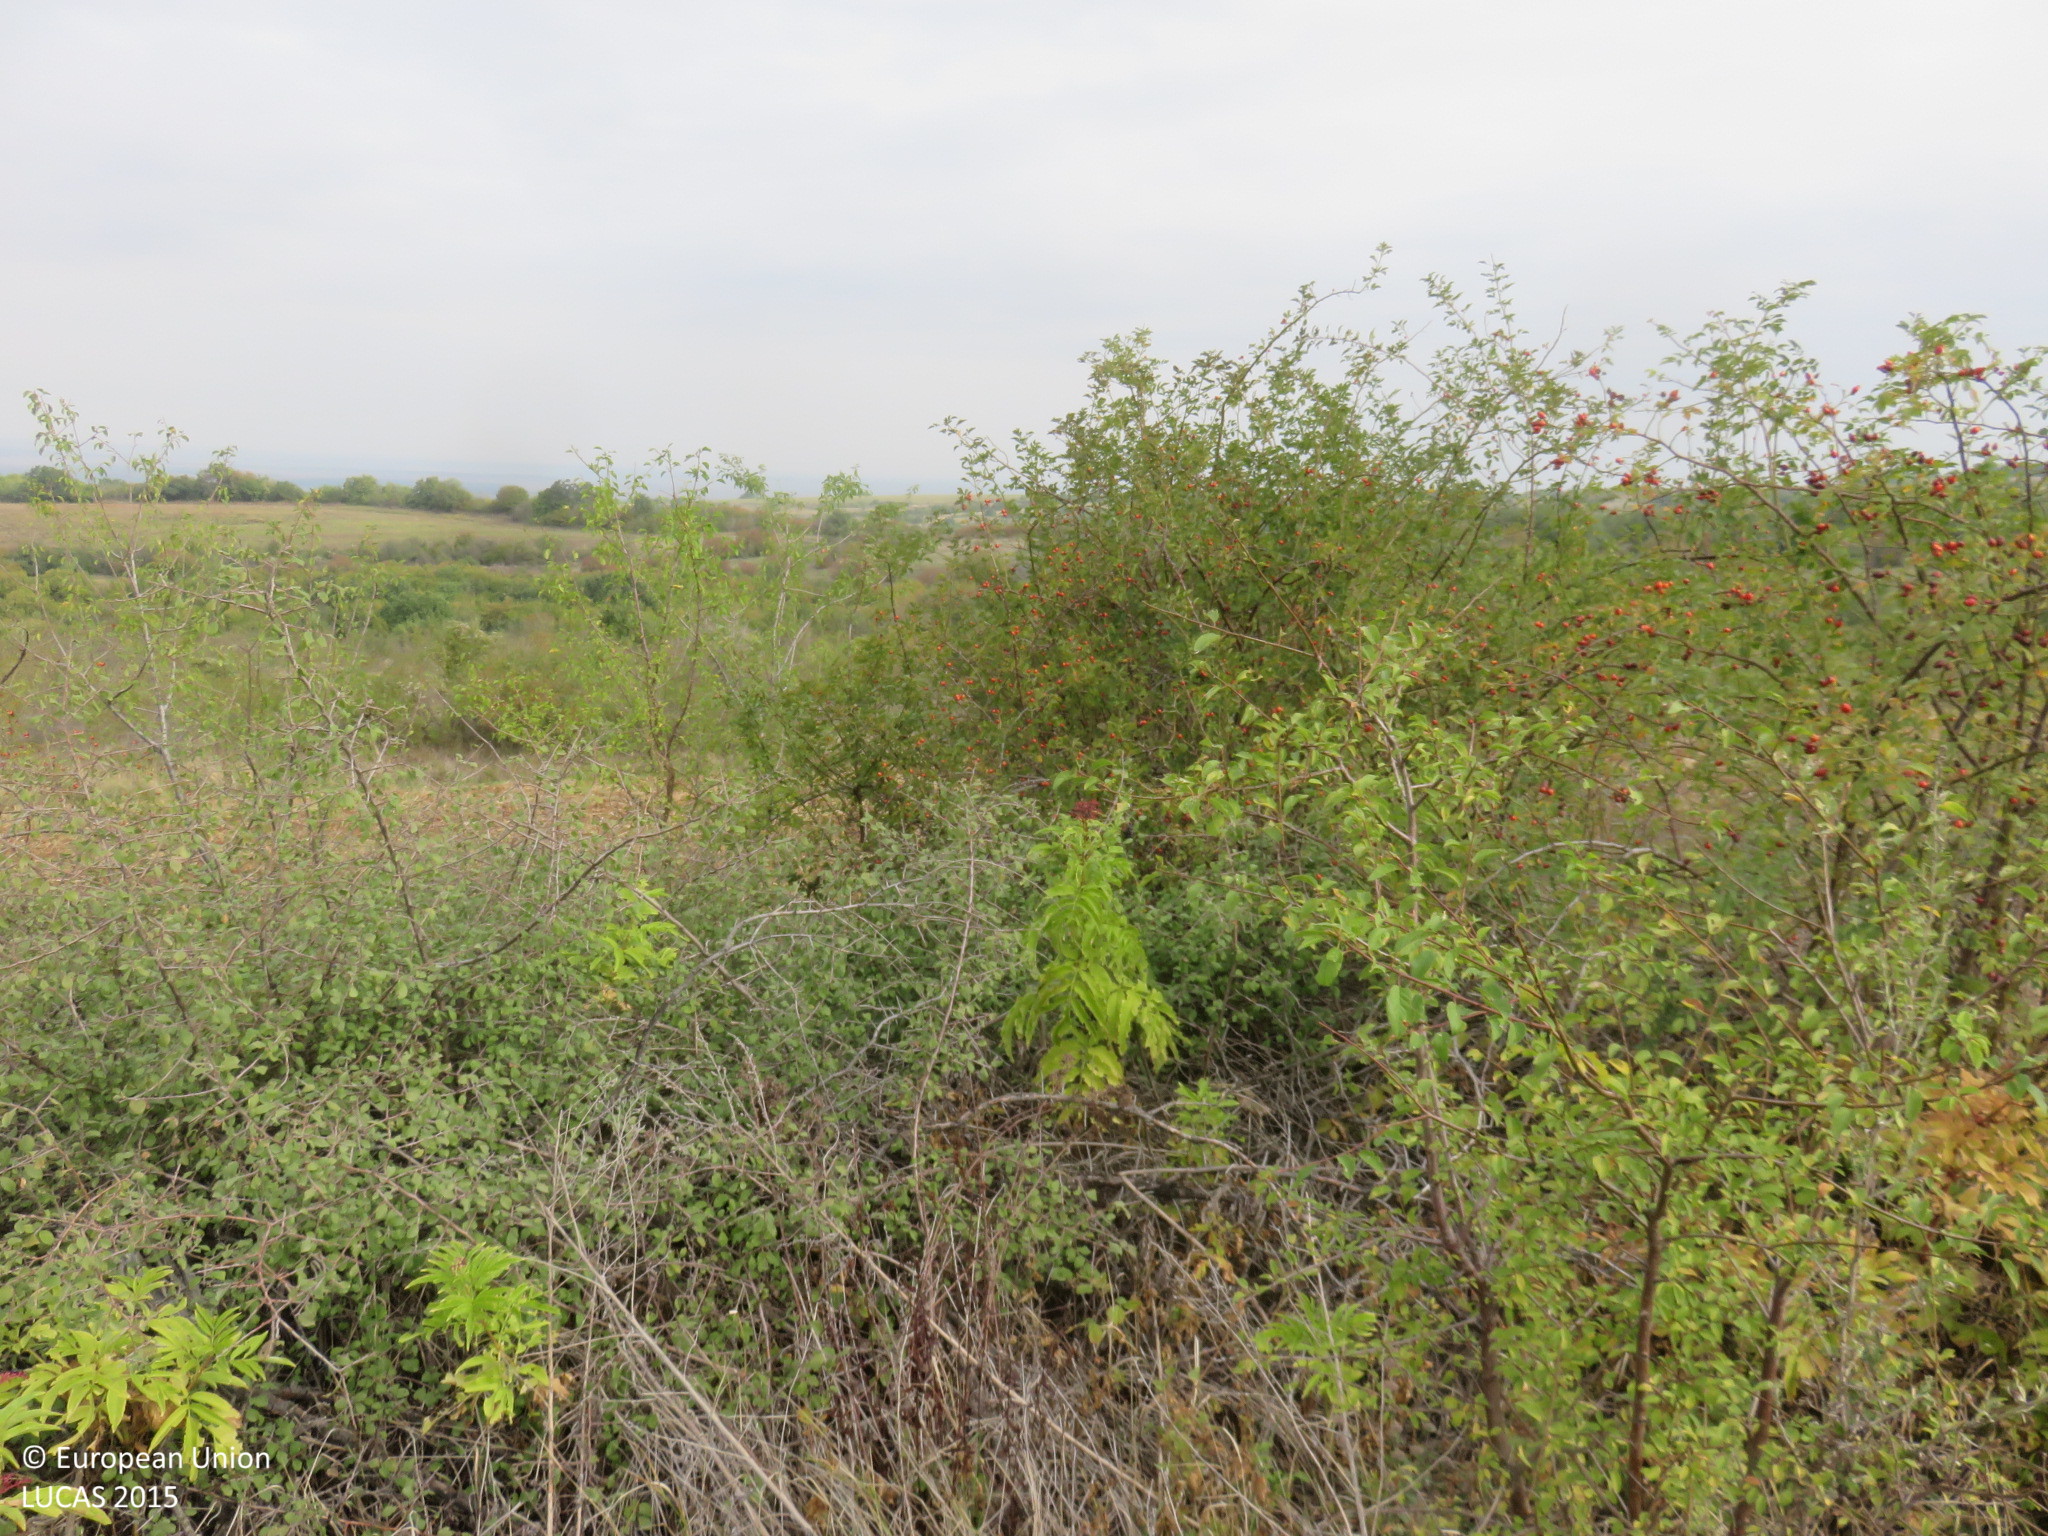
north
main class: Shrubland
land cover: Shrubland with sparse tree cover
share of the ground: > 75 %
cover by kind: shrubs 90 %, broadleaved forest trees 5 %, herbaceous plants 5 %
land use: Semi-natural and natural areas not in use
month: September
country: BG
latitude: 43.1988
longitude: 24.8702
